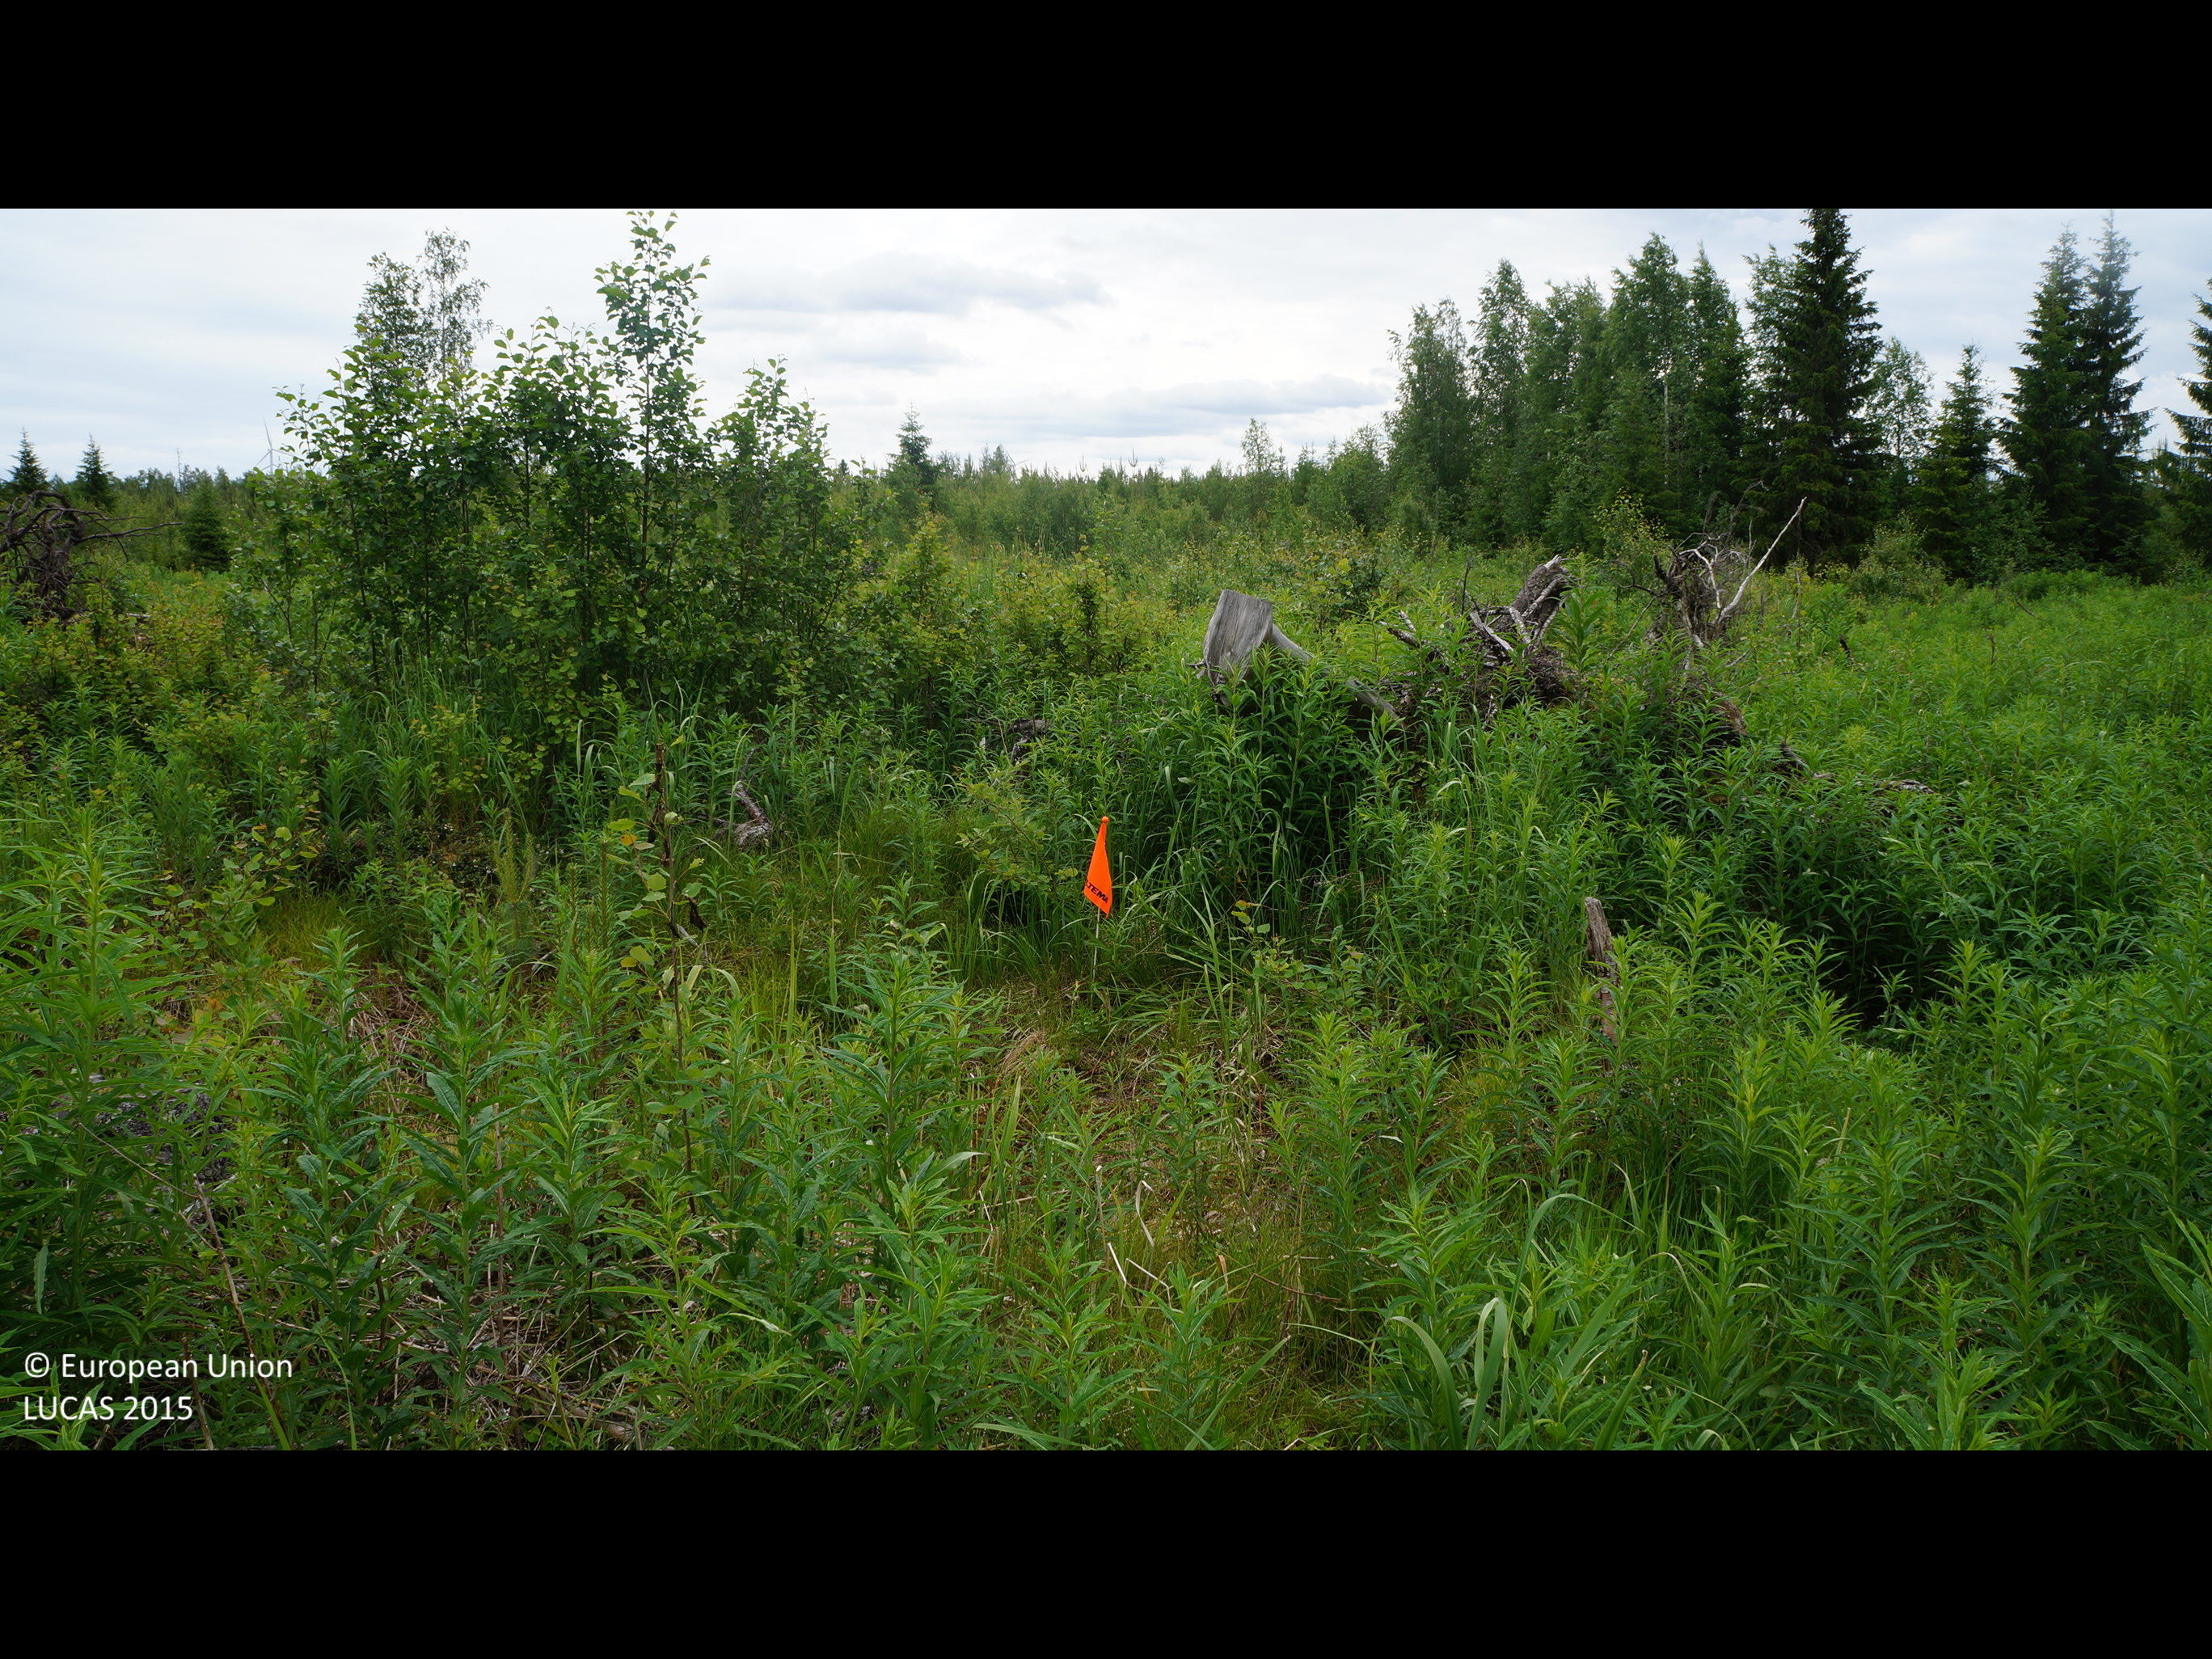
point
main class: Grassland
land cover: Grassland with sparse tree/shrub cover
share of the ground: > 75 %
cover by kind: herbaceous plants 90 %, broadleaved forest trees 5 %, shrubs 5 %
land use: Forestry
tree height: < 5 m
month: July
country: FI
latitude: 64.3508
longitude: 24.3339
